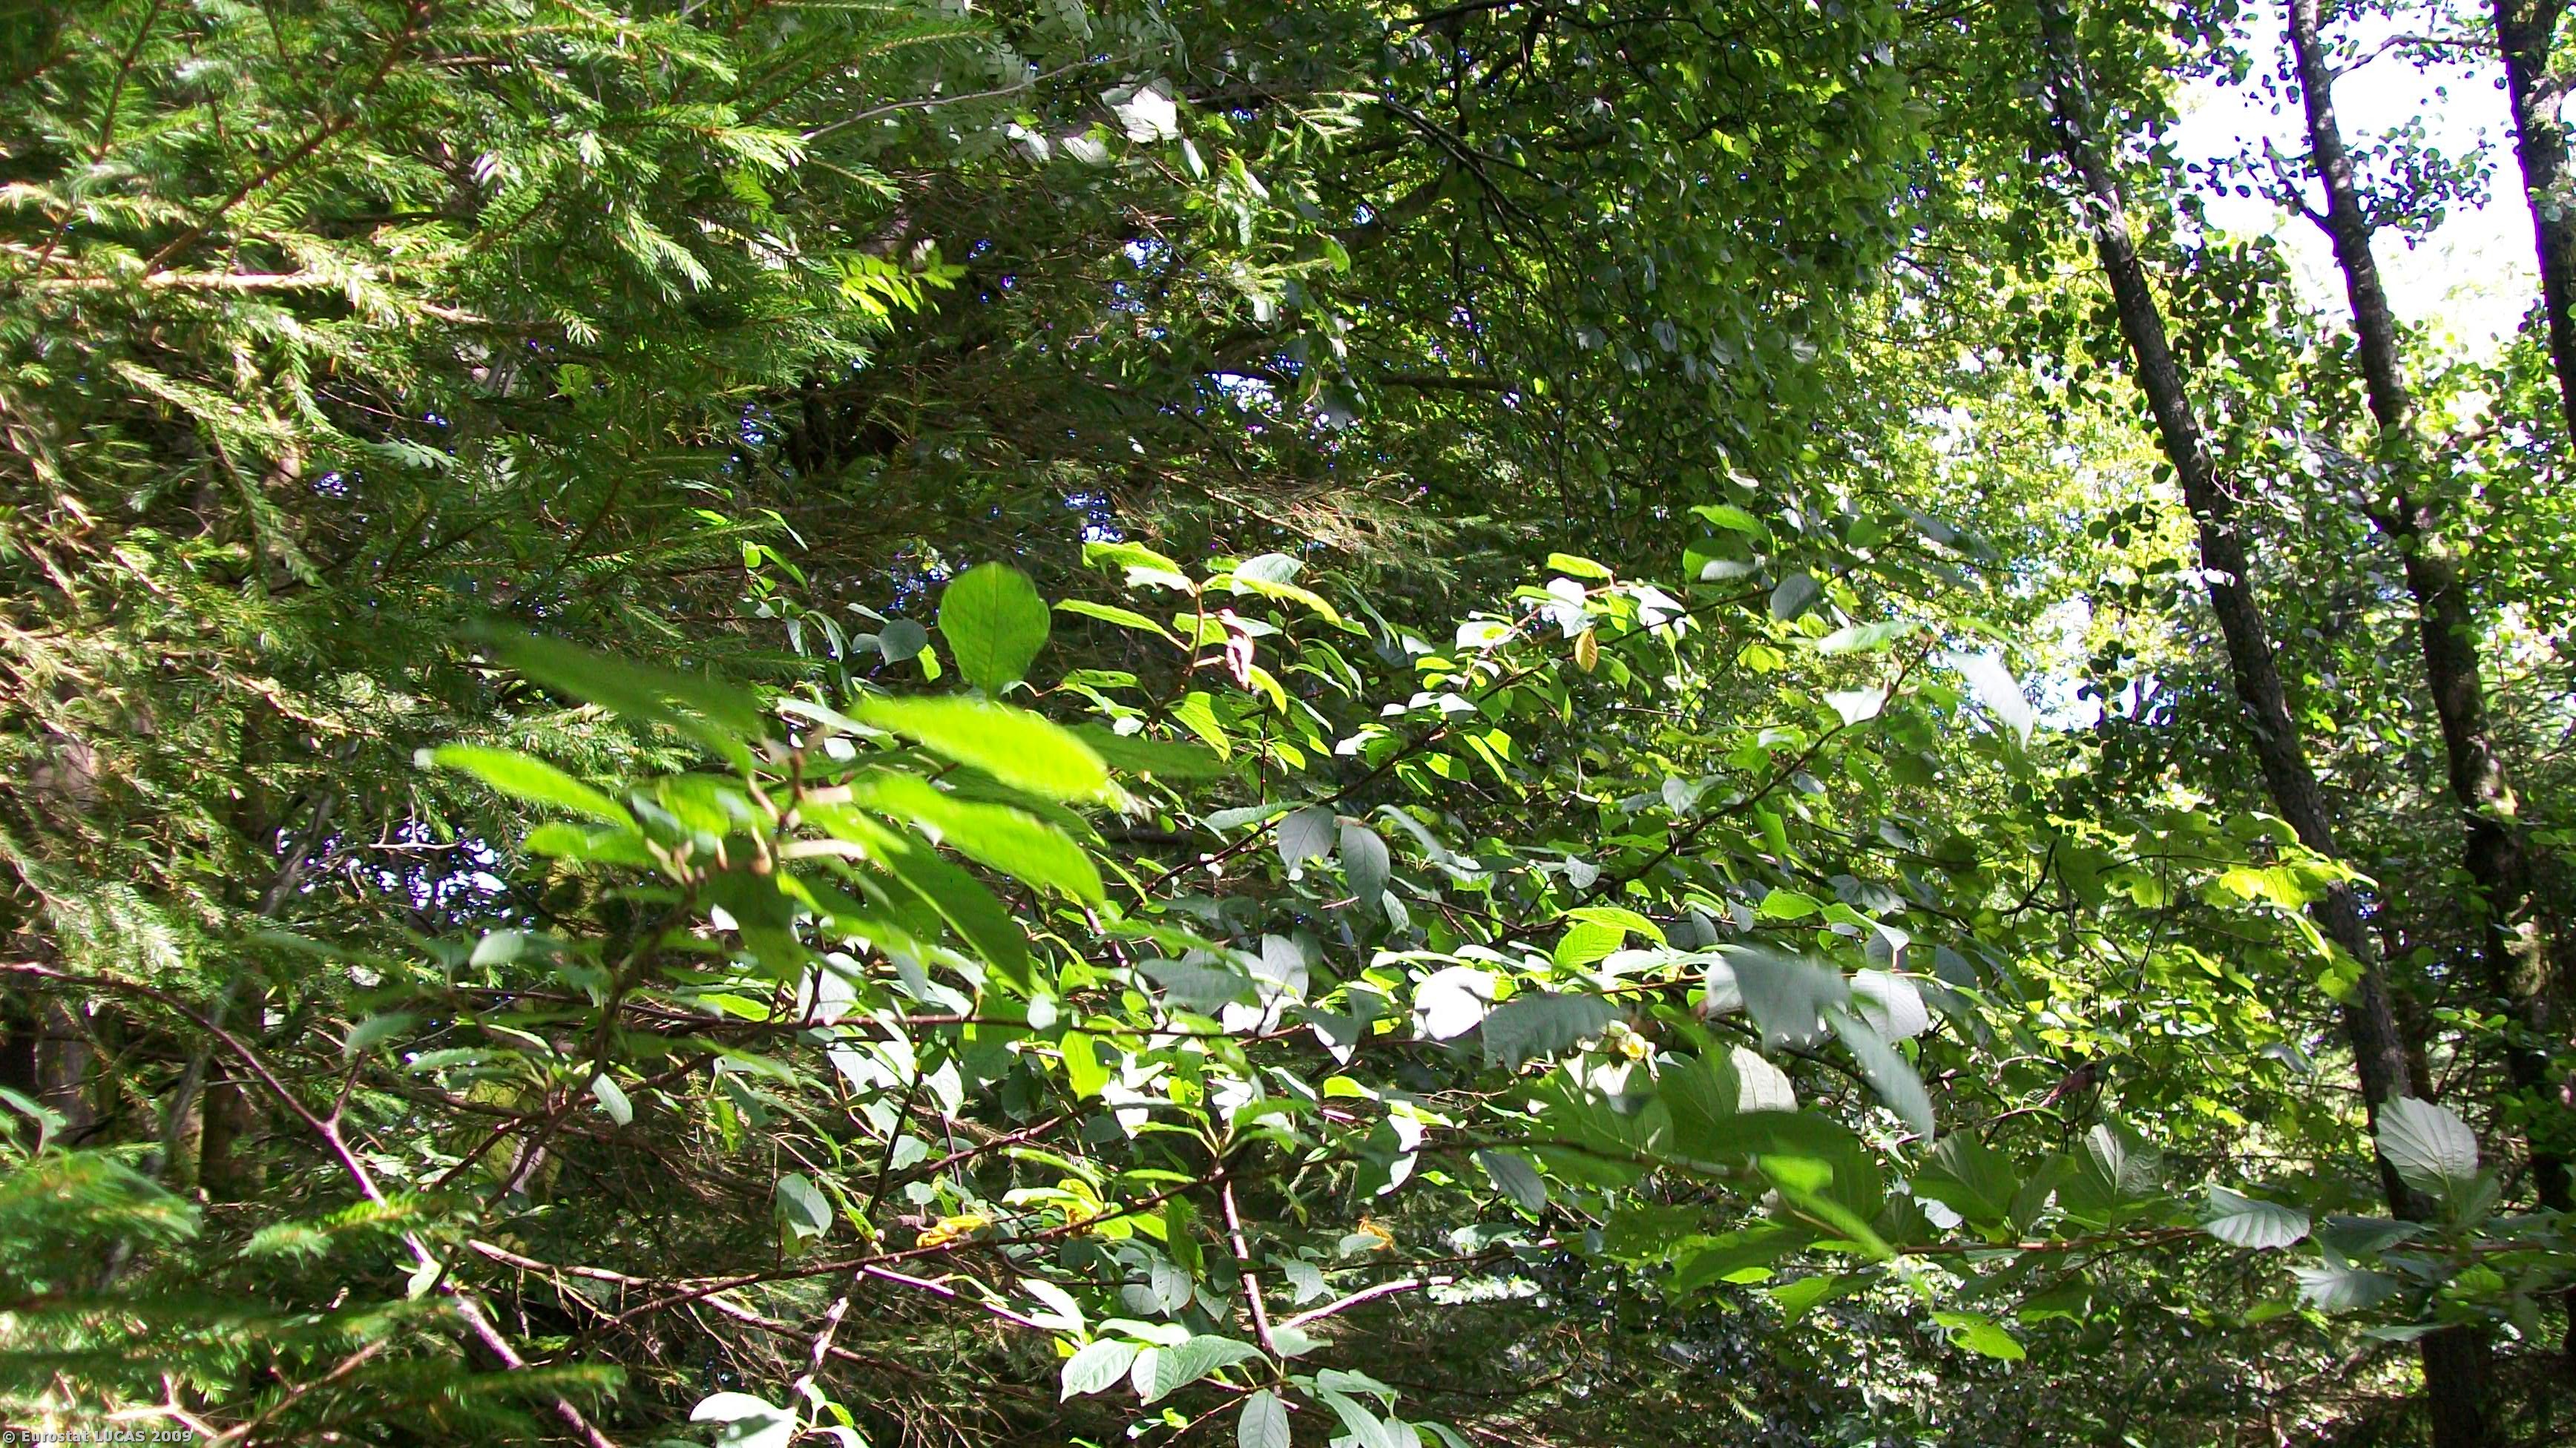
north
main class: Woodland
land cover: Mixed woodland
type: hemiboreal forest and nemoral coniferous forest and mixed broadleaved-coniferous forest
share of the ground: > 75 %
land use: Unused
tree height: > 5 m
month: August
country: GB
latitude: 55.3138
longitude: -3.4238
